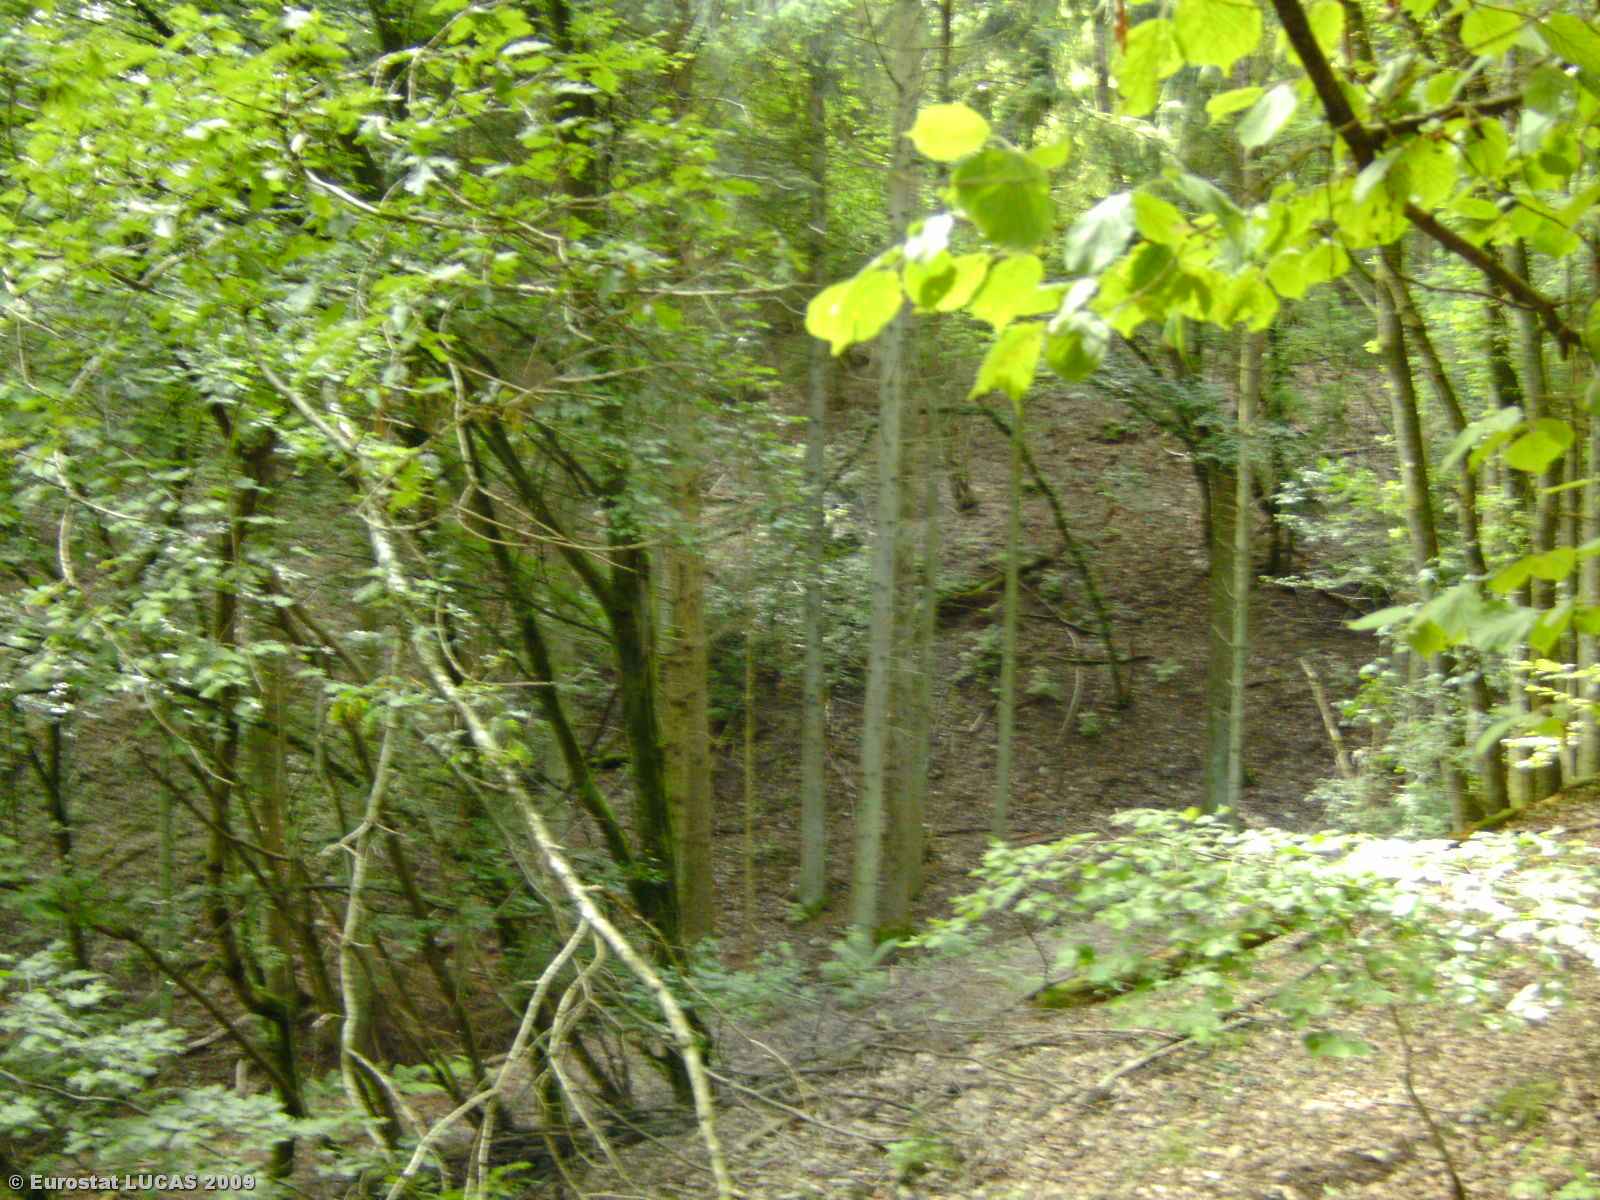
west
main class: Woodland
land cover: Broadleaved woodland
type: mesophytic deciduous forest
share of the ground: > 75 %
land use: Forestry
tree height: > 5 m
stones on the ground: < 10 %
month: June
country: LU
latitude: 49.9219
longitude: 6.1690
